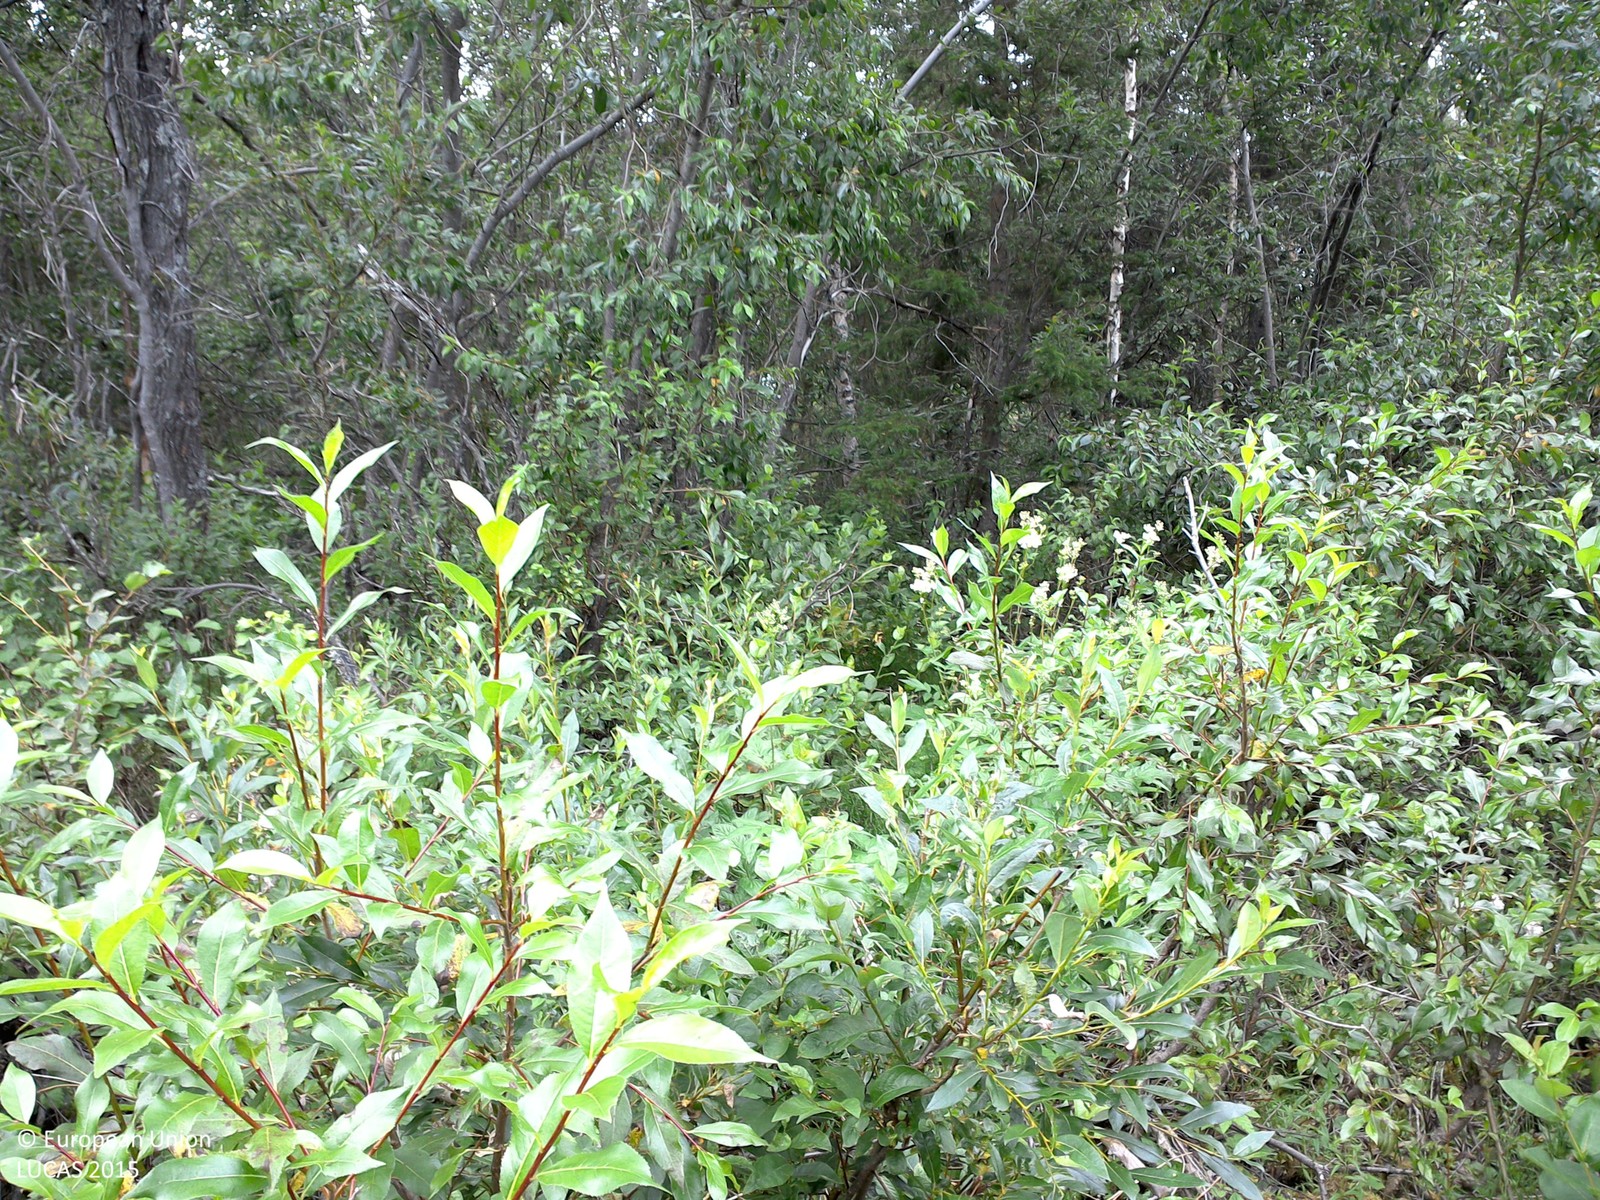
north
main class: Woodland
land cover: Broadleaved woodland
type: boreal forest
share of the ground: 25 - 50 %
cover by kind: shrubs 55 %, broadleaved forest trees 40 %, coniferous forest trees 5 %
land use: Forestry
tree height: > 5 m
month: August
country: SE
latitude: 67.9336
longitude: 20.3619
